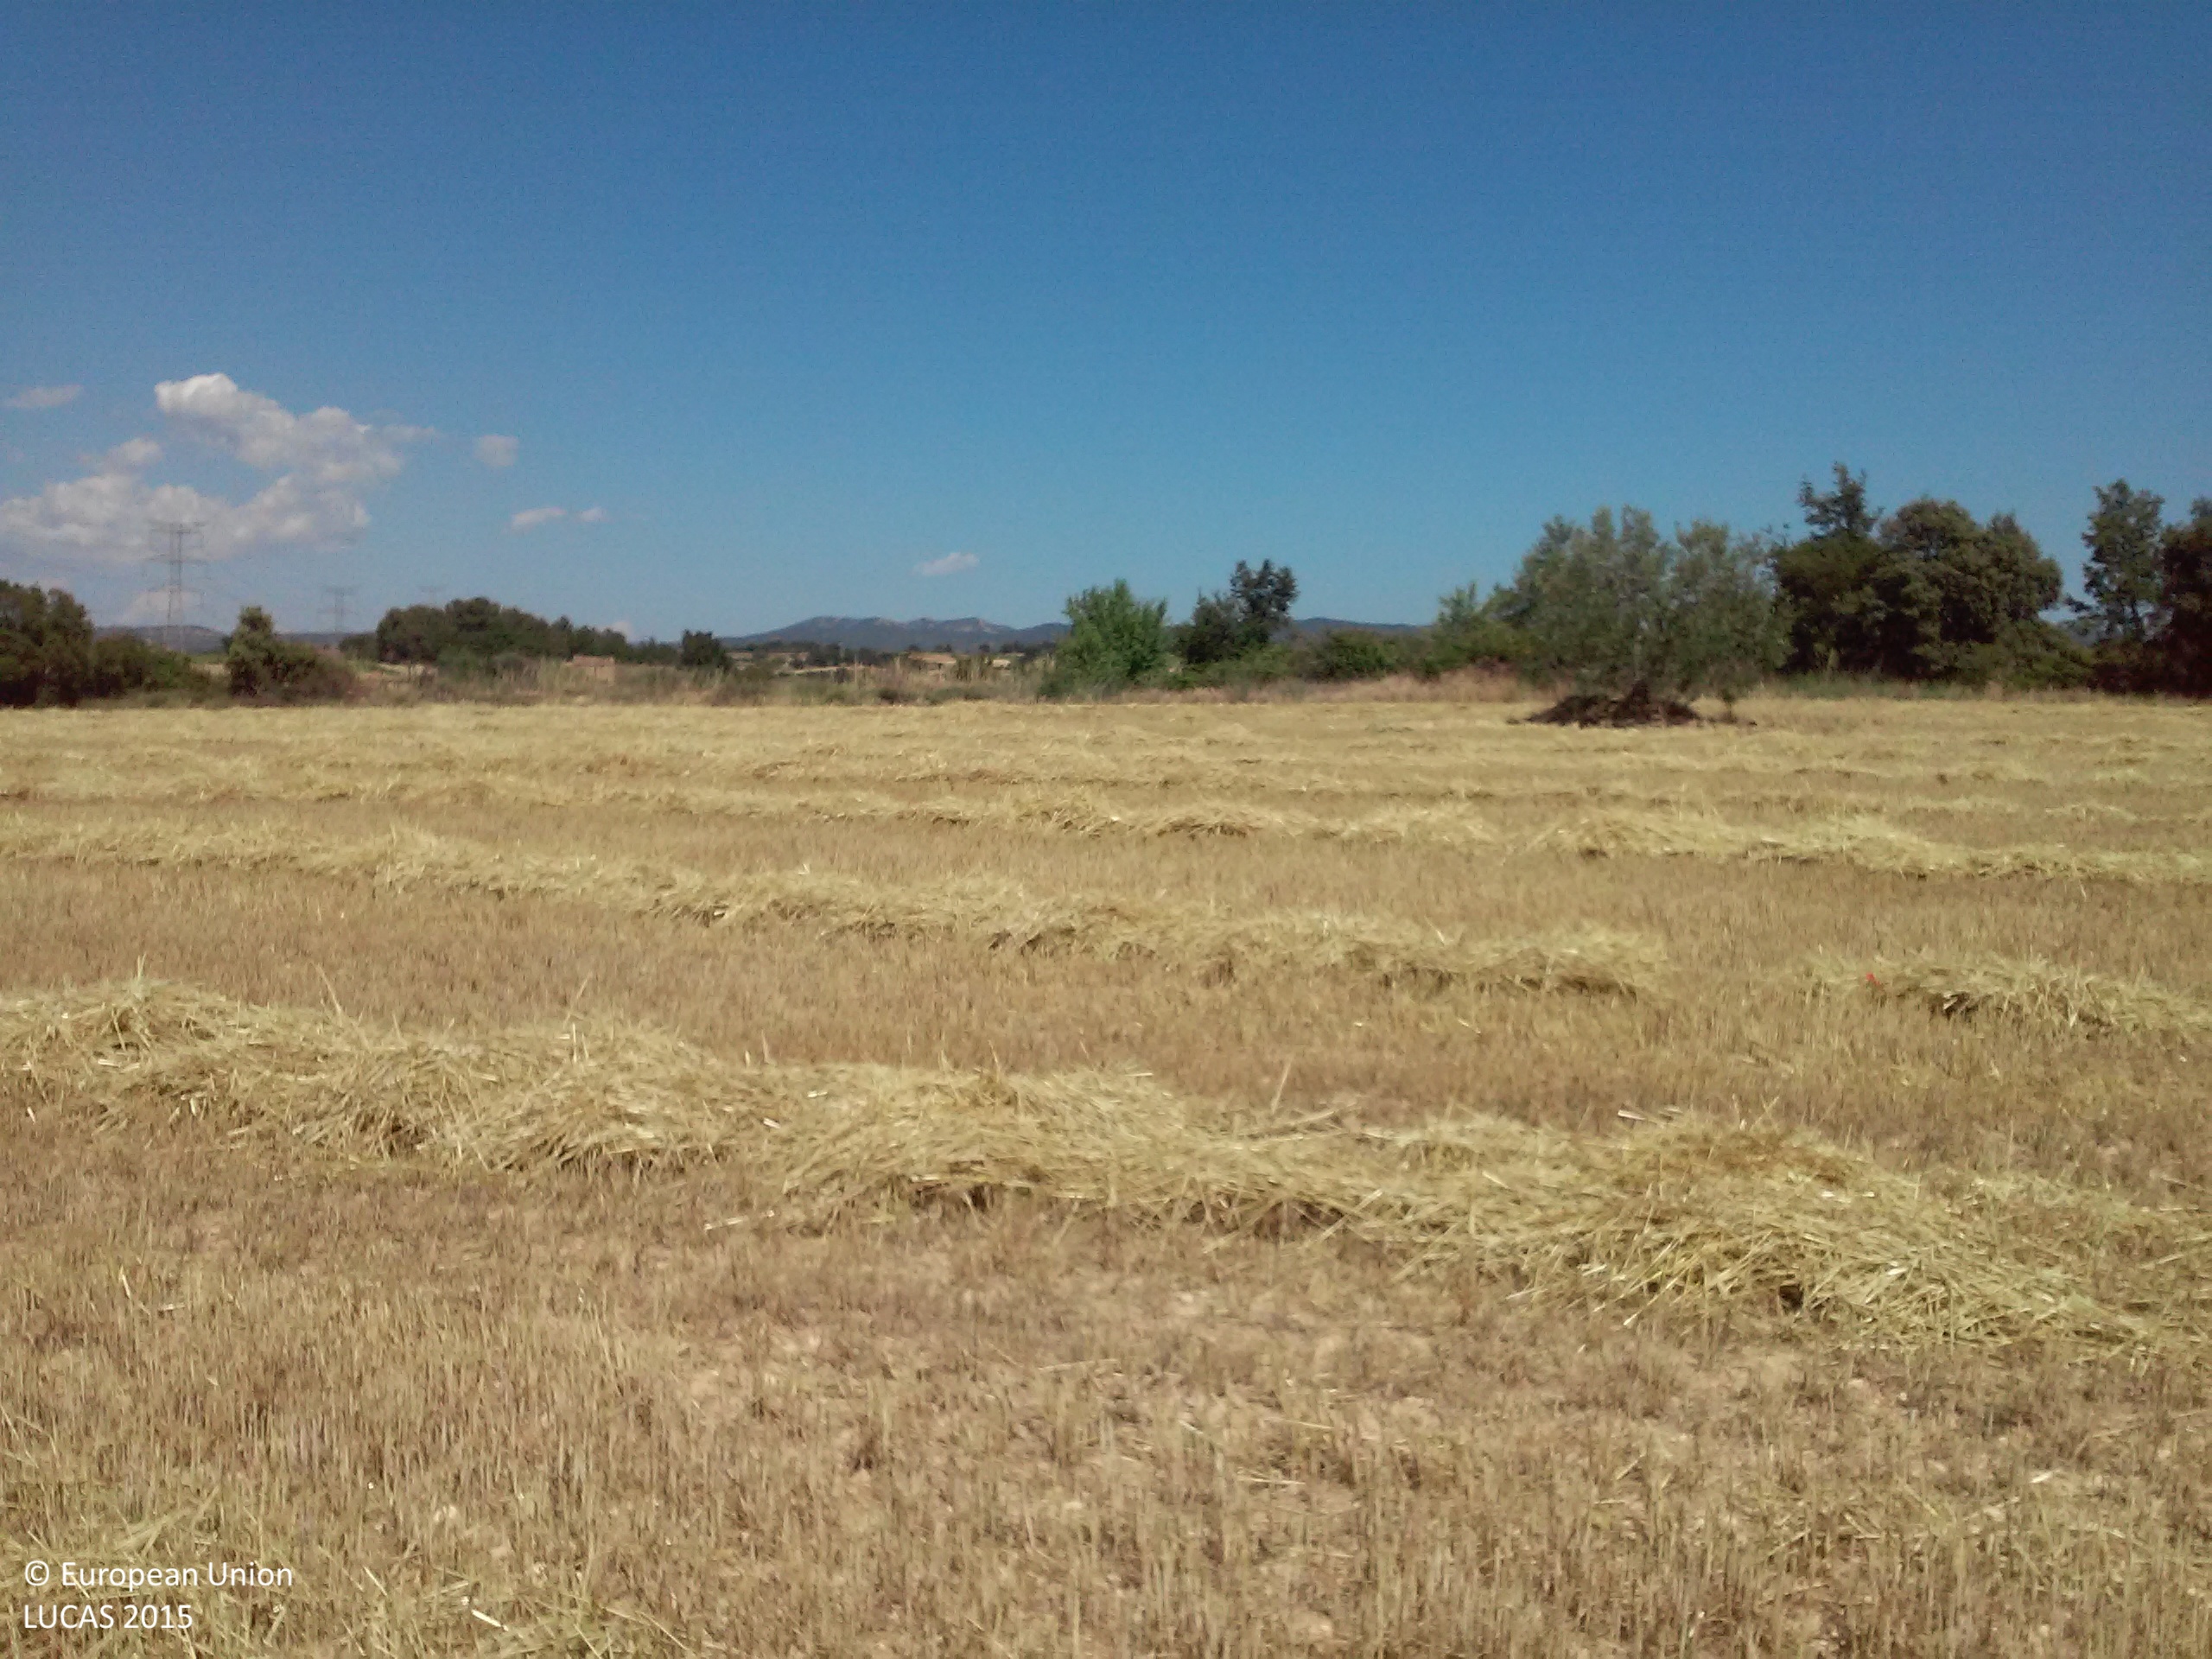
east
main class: Cropland
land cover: Barley
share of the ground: < 10 %
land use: Agriculture (excluding fallow land and kitchen gardens)
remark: Harvested field
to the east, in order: Barley; Grassland with sparse tree/shrub cover; Tracks; Shruby margins; Vineyards; Shruby margins; Vineyards; Shruby margins; Shrubland with sparse tree cover; Grassland with sparse tree/shrub cover; Common wheat; Grassland with sparse tree/shrub cover
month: June
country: ES
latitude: 41.4566
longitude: 1.2402
